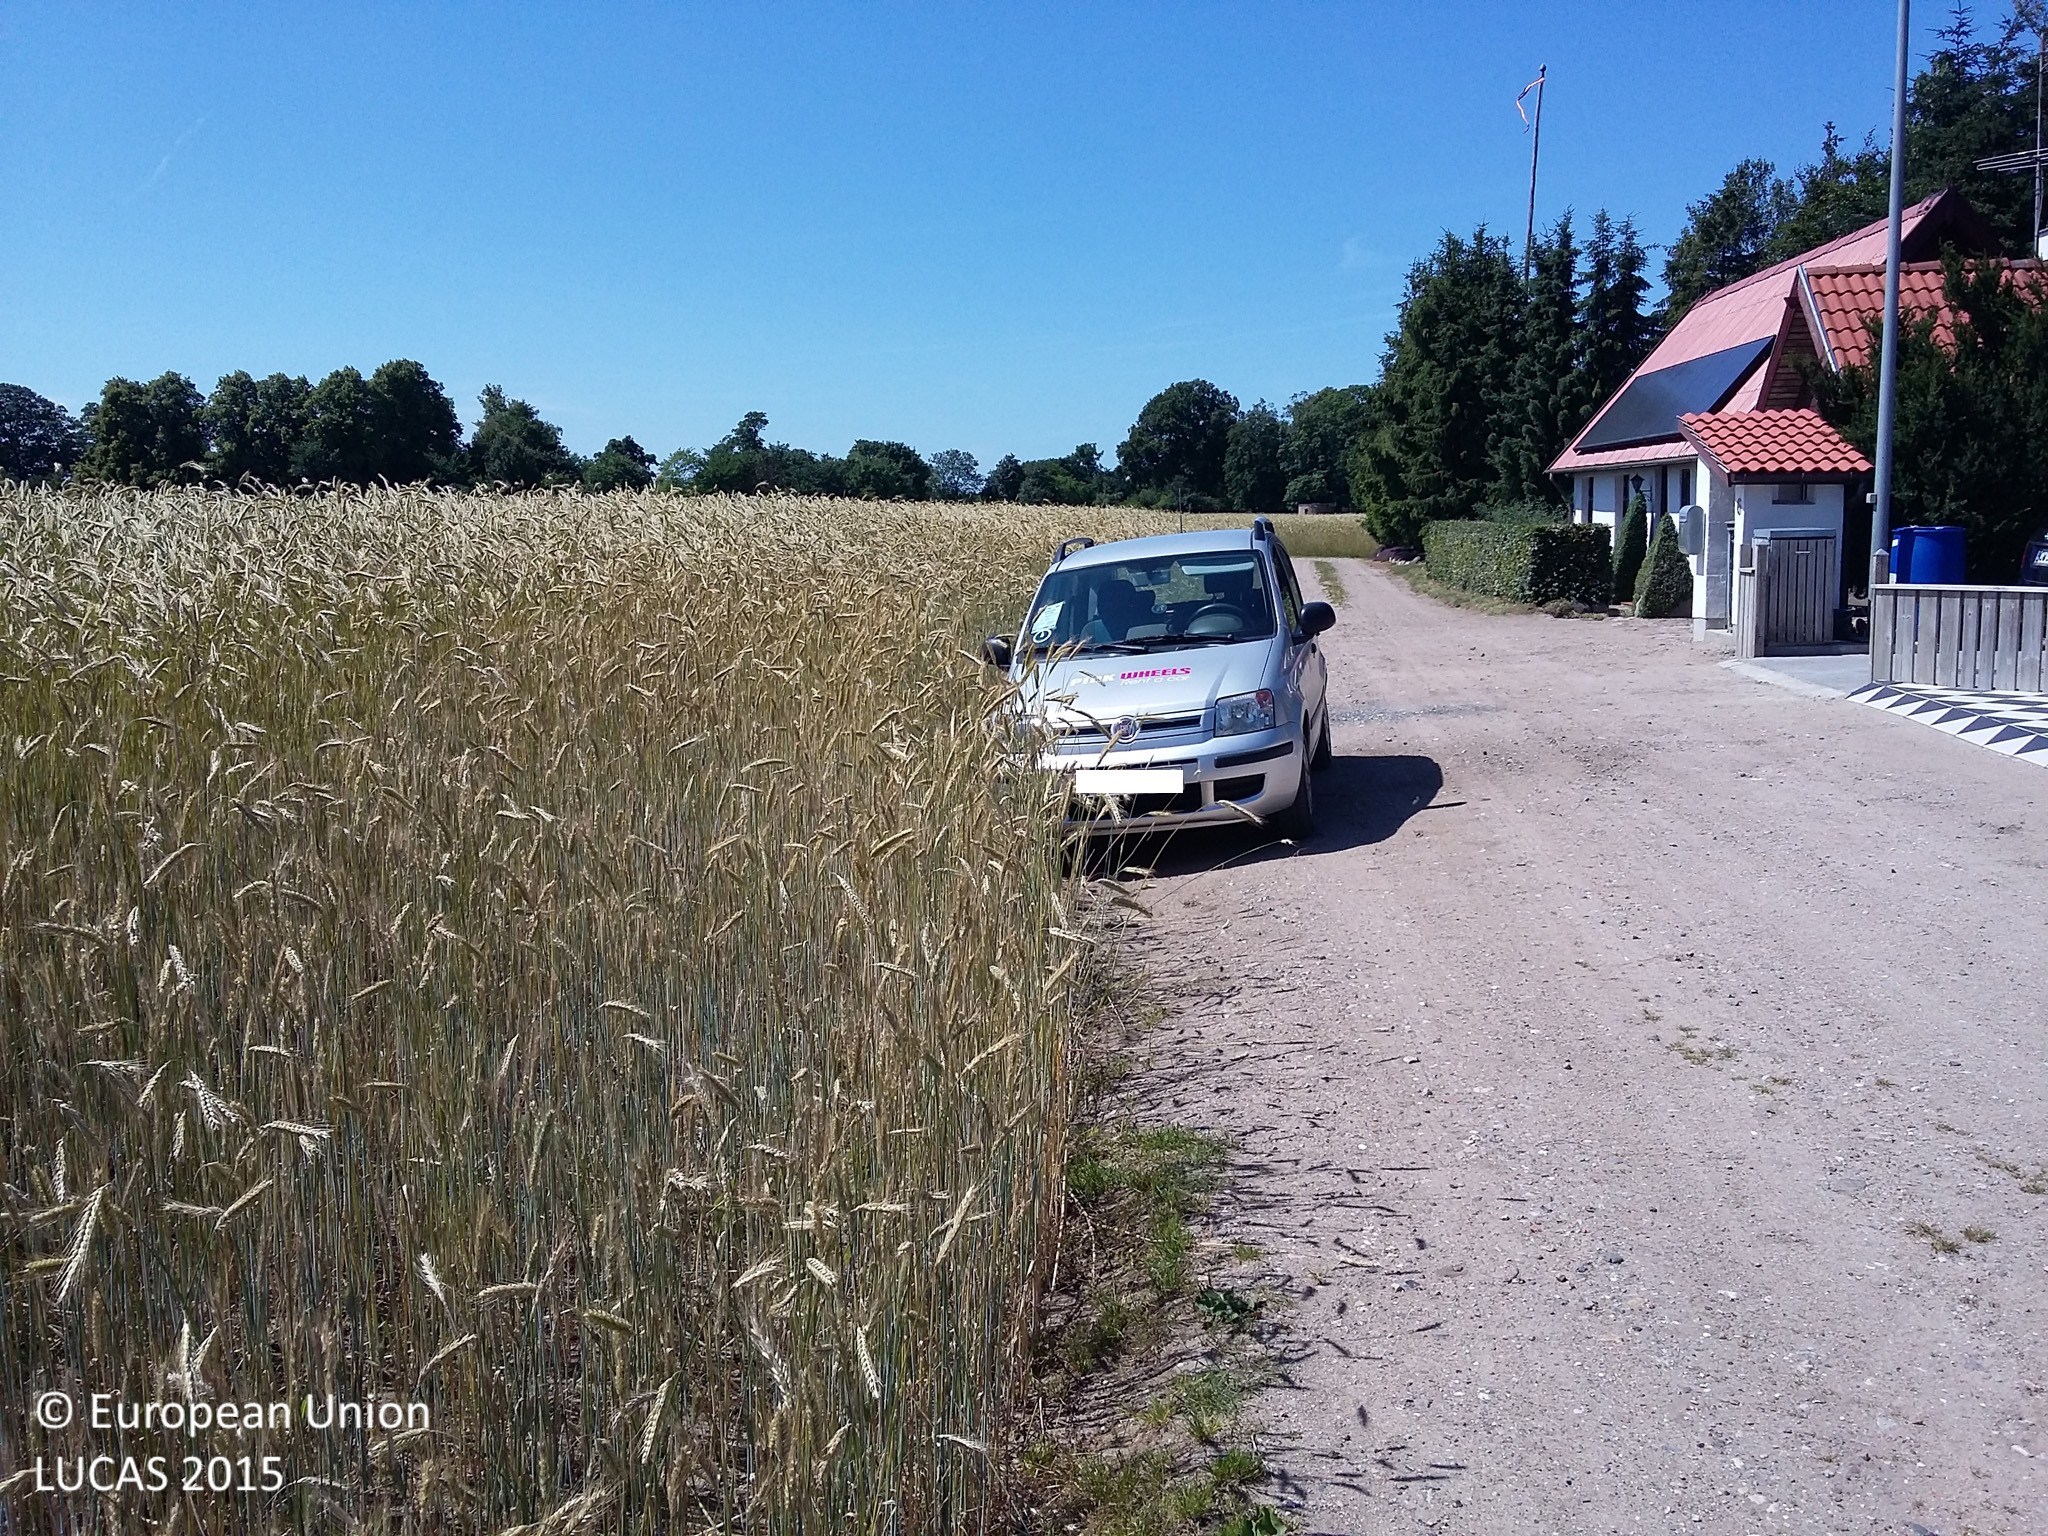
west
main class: Cropland
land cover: Rye
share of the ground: > 75 %
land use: Agriculture (excluding fallow land and kitchen gardens)
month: July
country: DK
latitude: 55.5677
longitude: 11.5051
